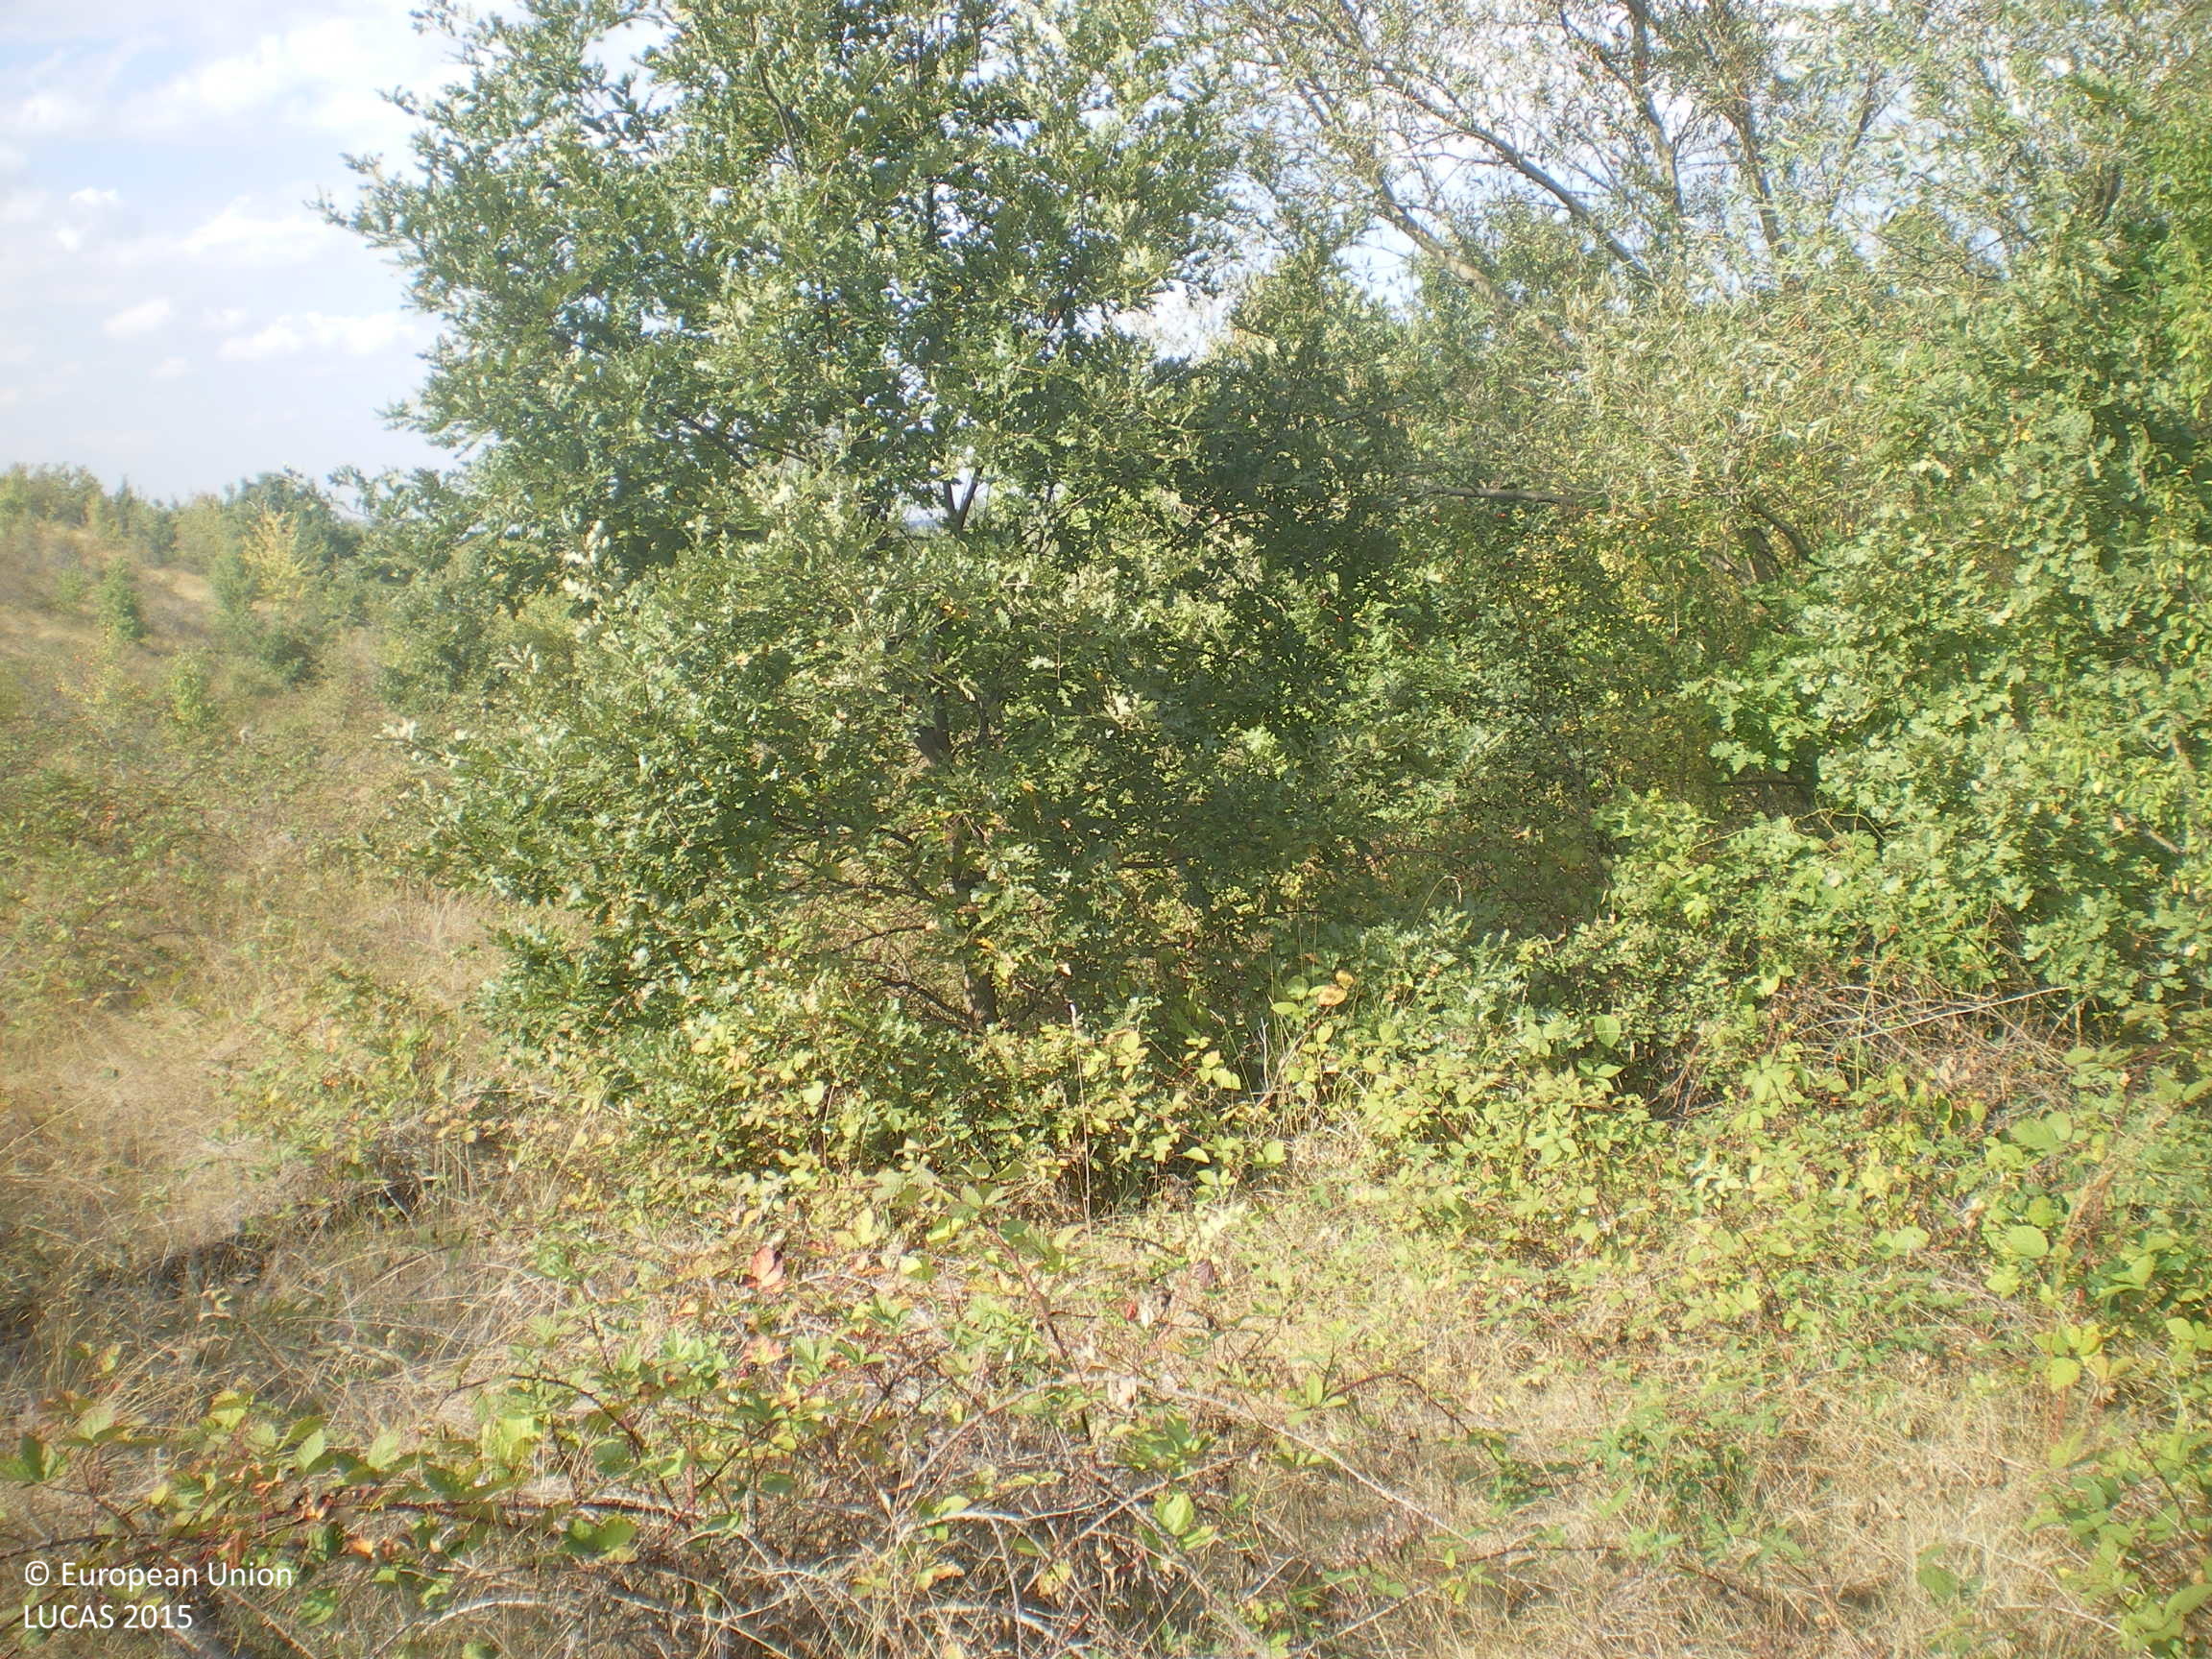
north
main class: Woodland
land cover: Broadleaved woodland
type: mesophytic deciduous forest
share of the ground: > 75 %
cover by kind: broadleaved forest trees 70 %, herbaceous plants 20 %, shrubs 10 %
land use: Semi-natural and natural areas not in use
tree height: > 5 m
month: September
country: BG
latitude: 42.0879
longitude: 26.1210
